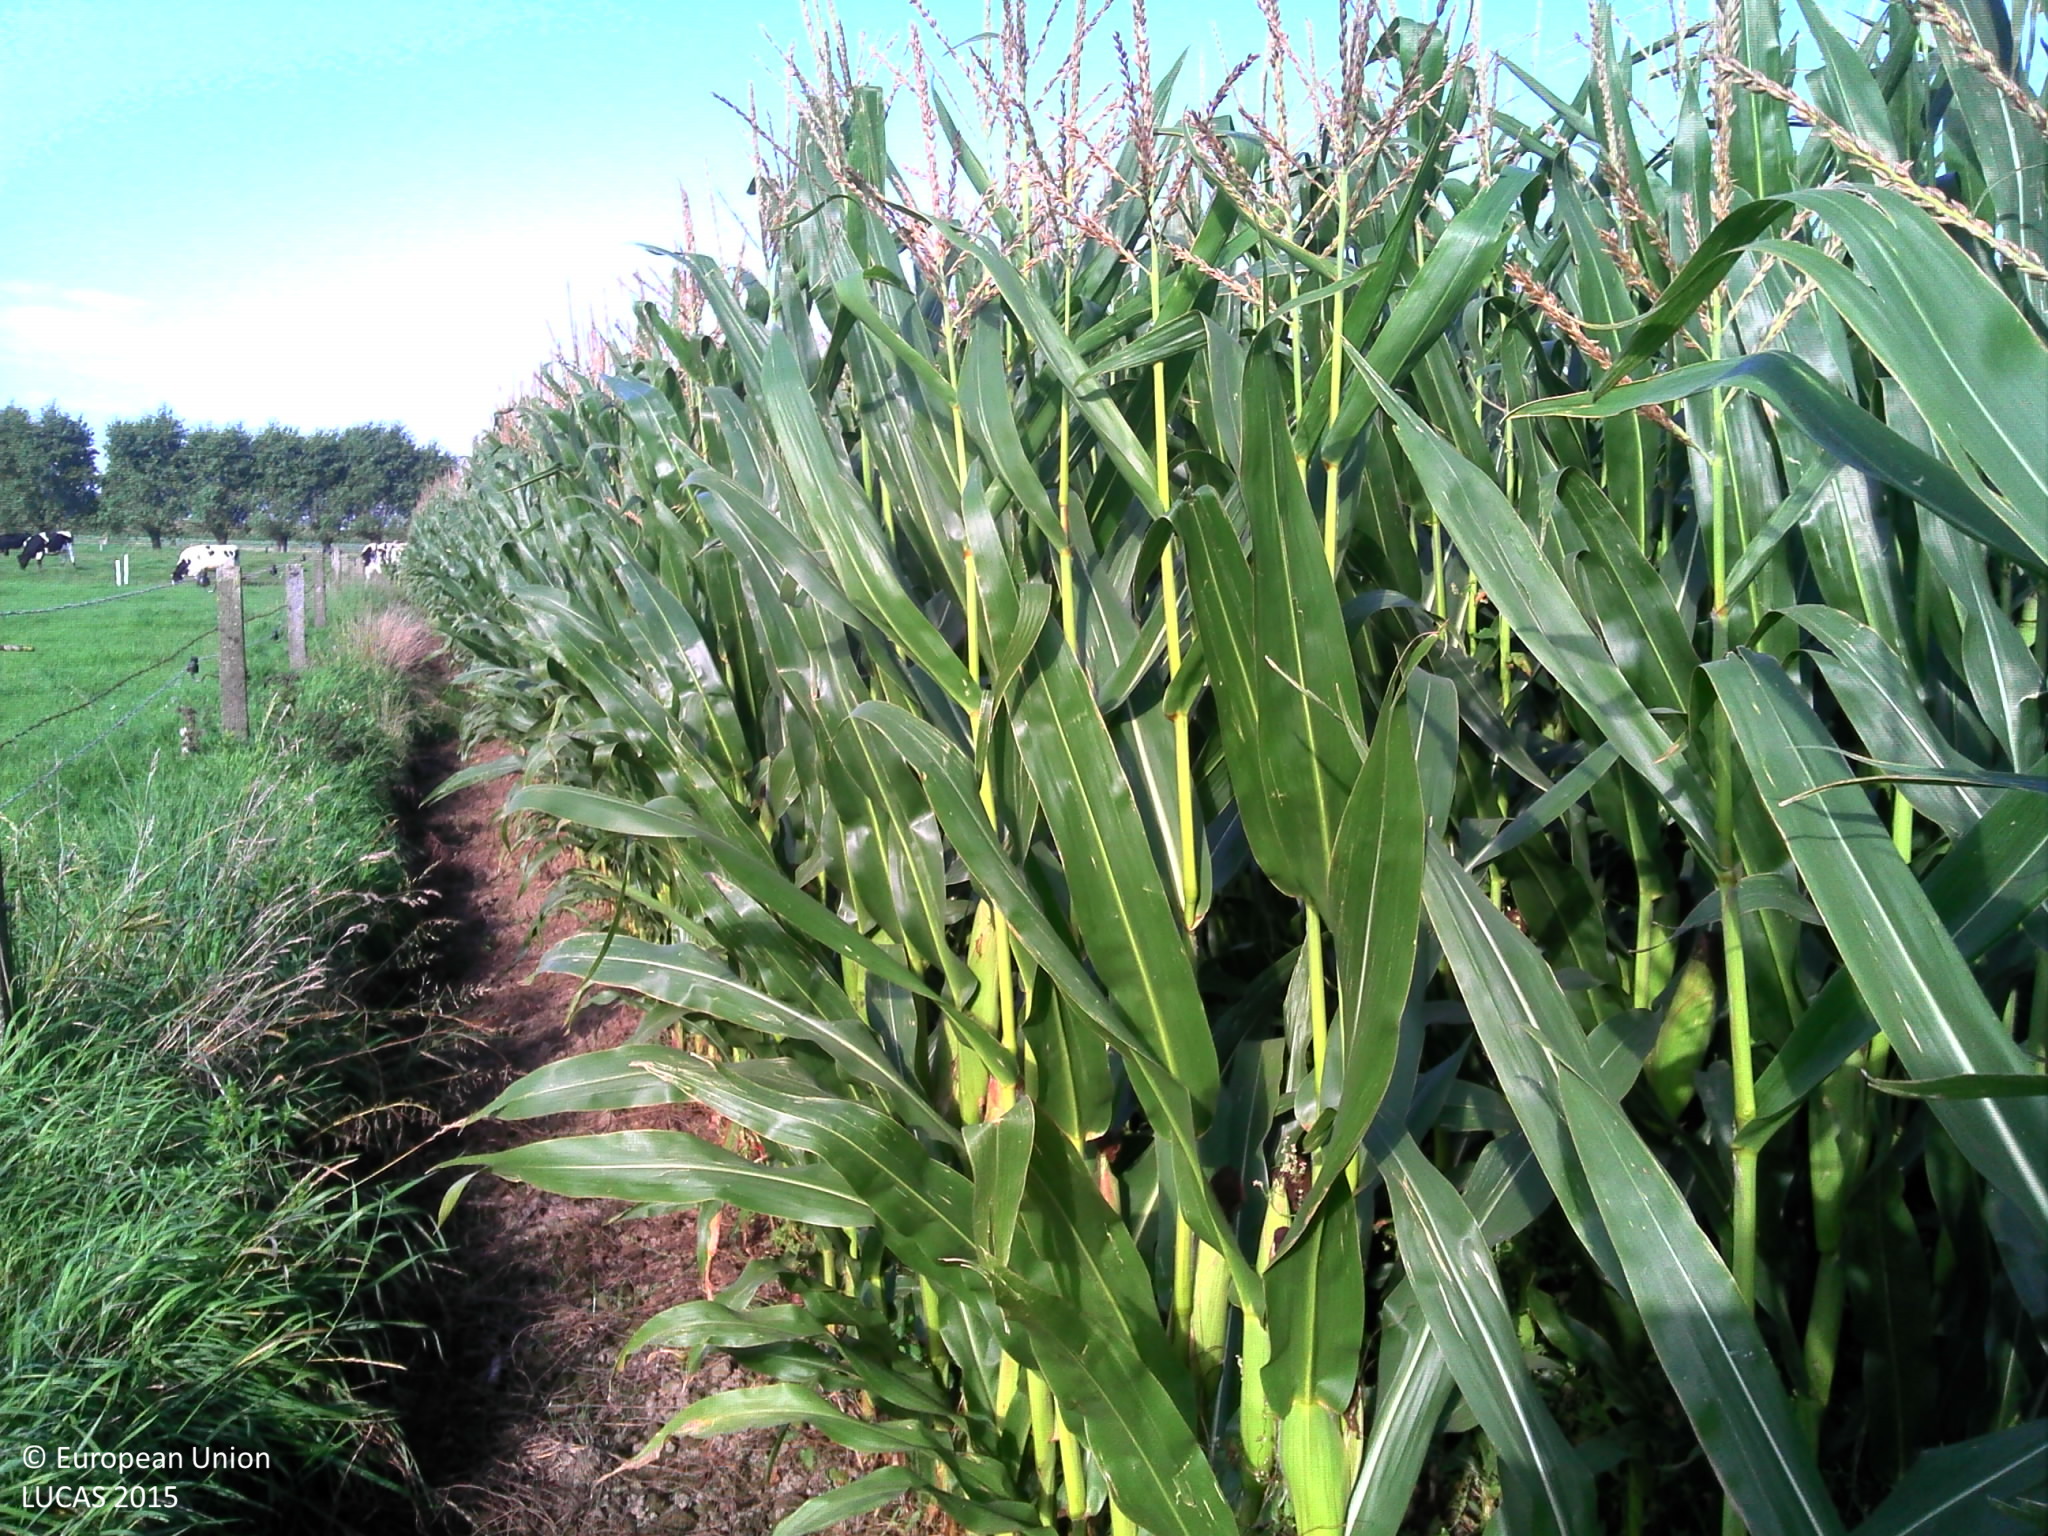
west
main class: Cropland
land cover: Maize
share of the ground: > 75 %
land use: Agriculture (excluding fallow land and kitchen gardens)
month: September
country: BE
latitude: 50.9977
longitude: 2.7071
